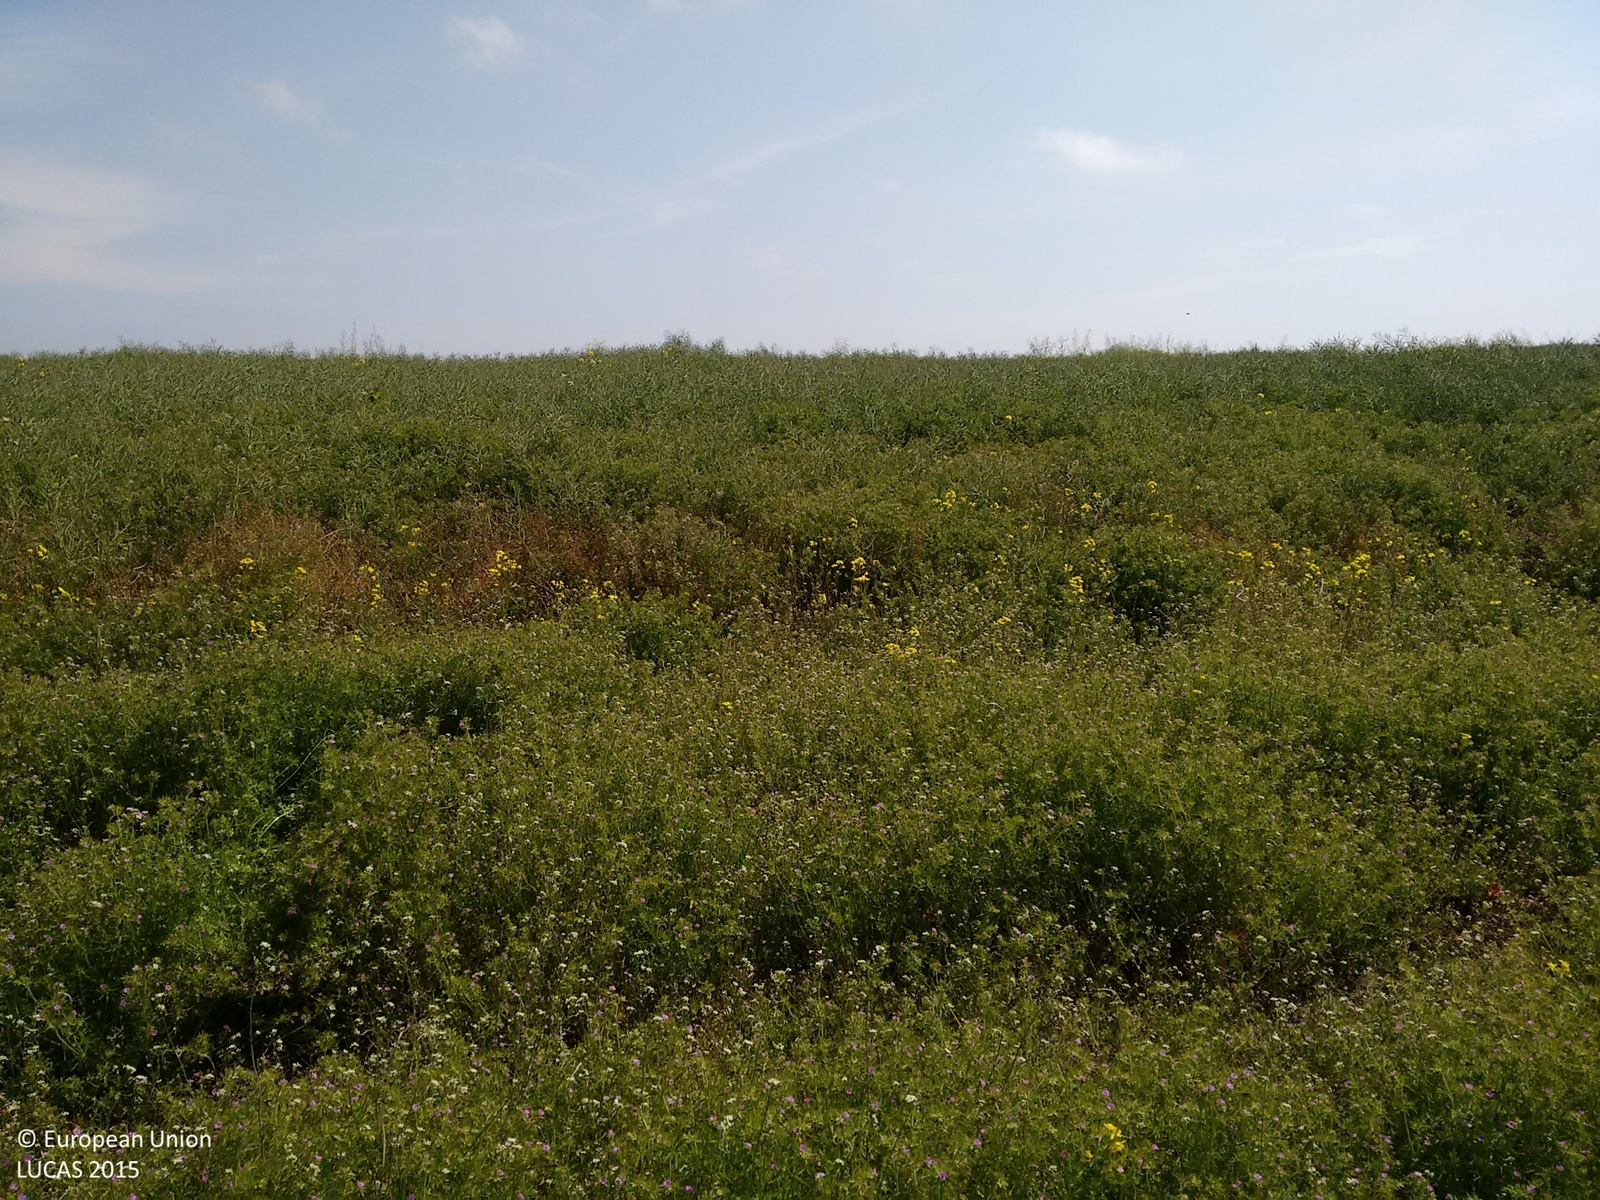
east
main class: Grassland
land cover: Spontaneously vegetated surfaces
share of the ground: > 75 %
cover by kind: herbaceous plants 100 %
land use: Agriculture (excluding fallow land and kitchen gardens)
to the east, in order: Spontaneously vegetated surfaces; Rape and turnip rape
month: June
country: GB
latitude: 52.9614
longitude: -0.7145
